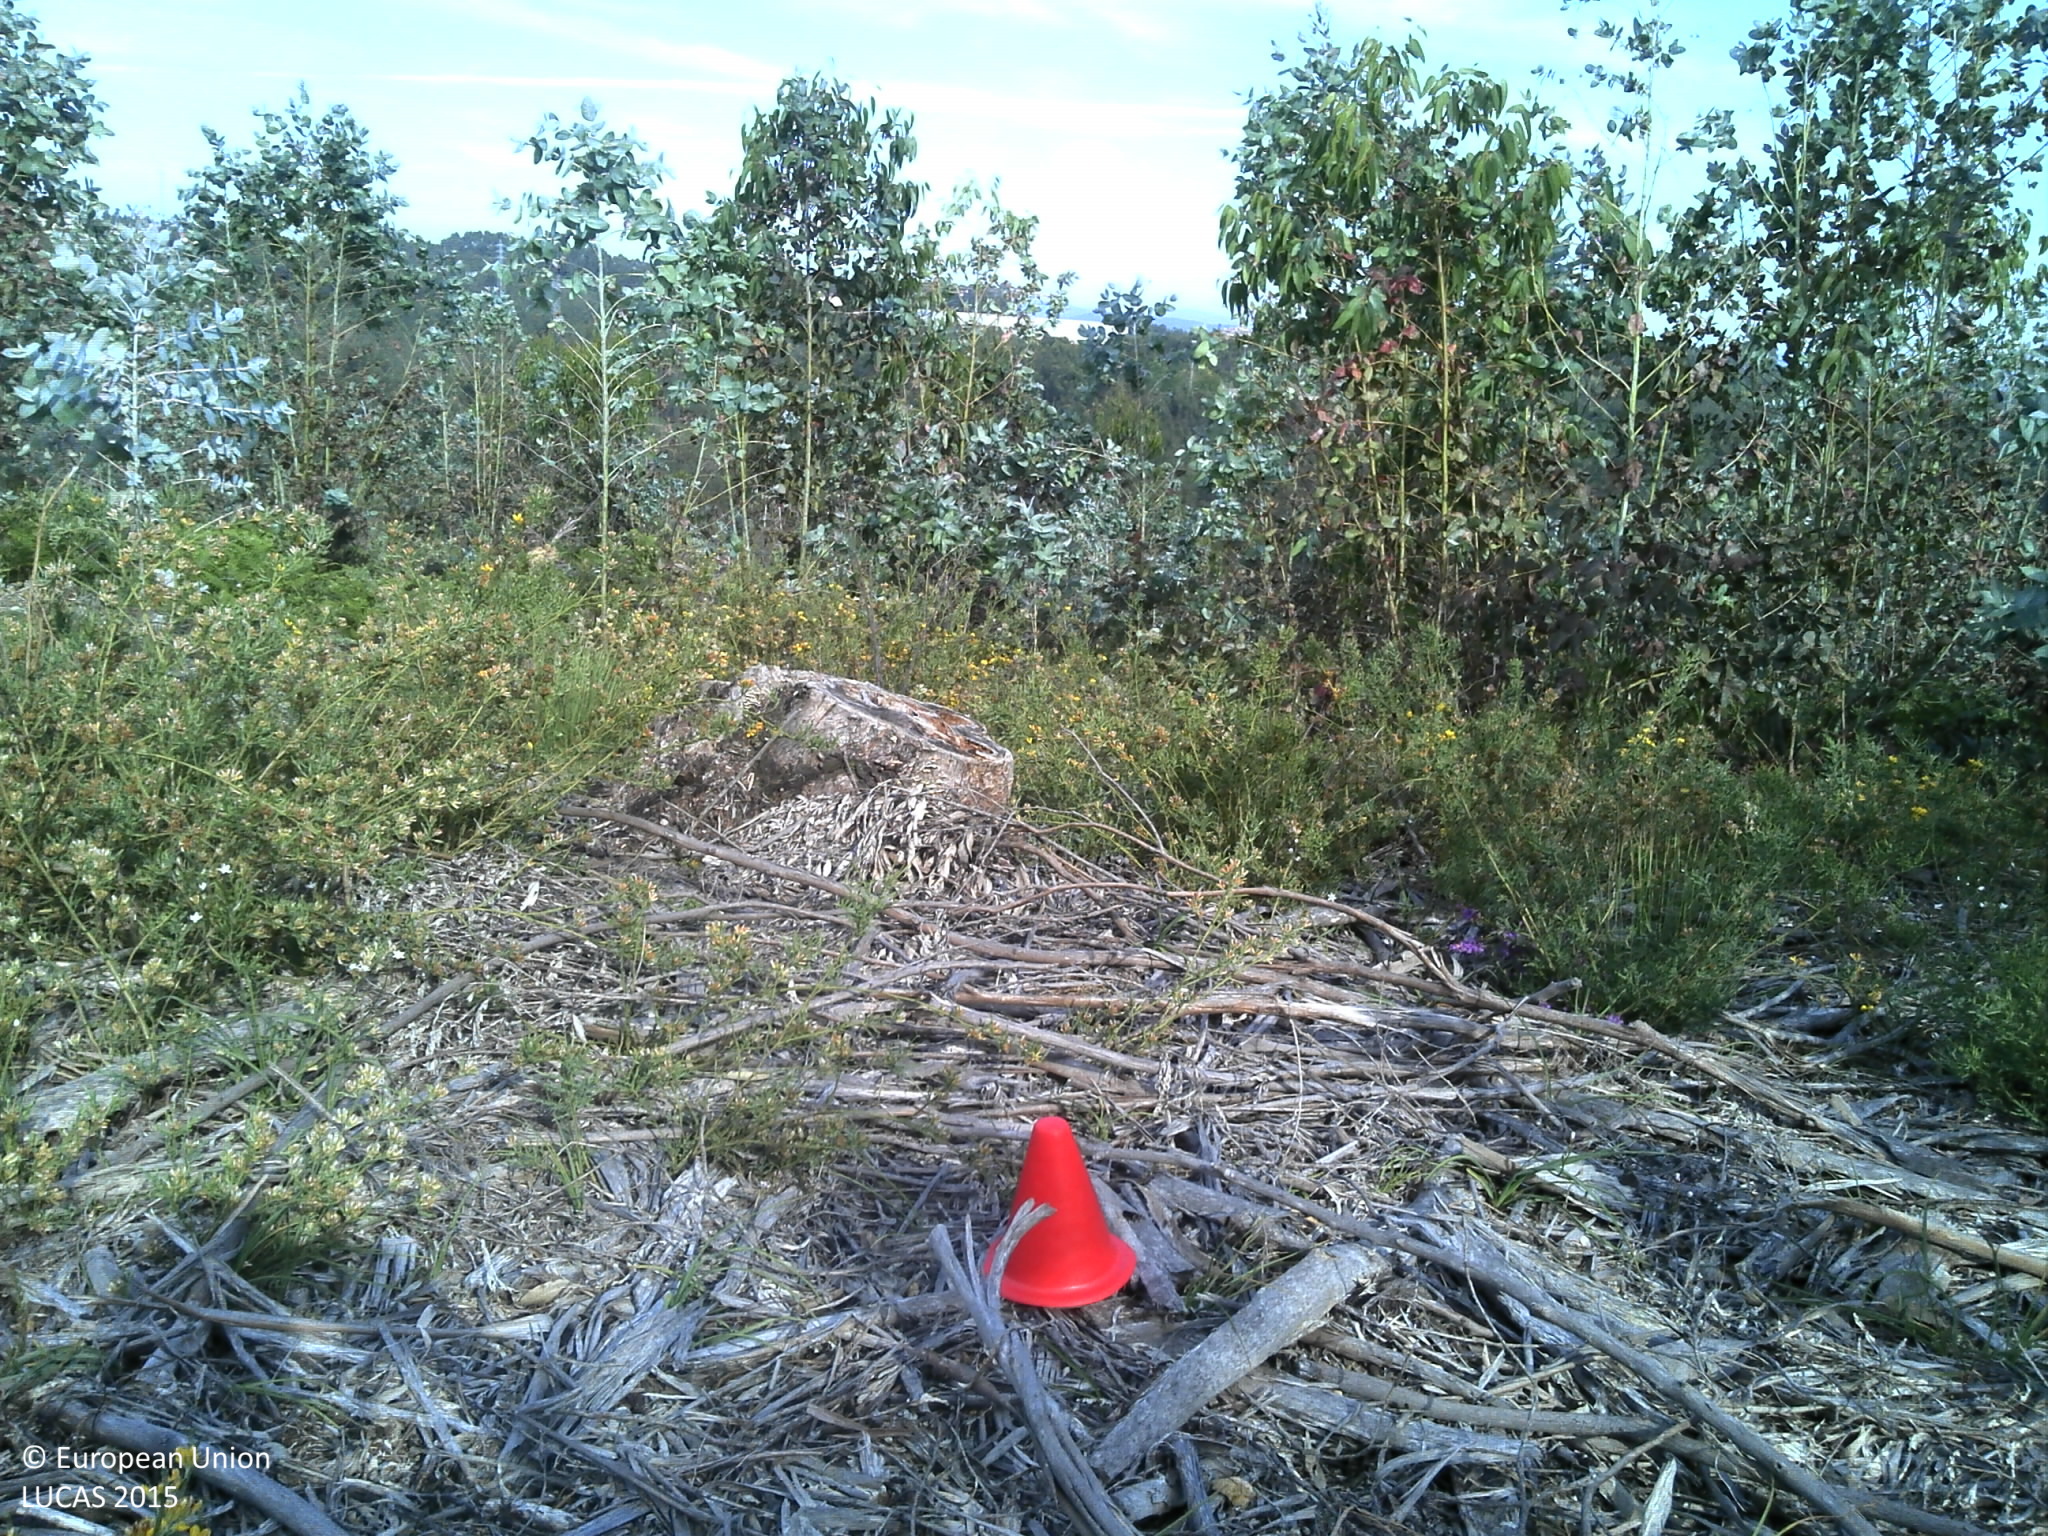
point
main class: Woodland
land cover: Broadleaved woodland
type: exotic forest
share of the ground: 10 - 25 %
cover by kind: unconsolidated bare surface 80 %, broadleaved forest trees 15 %, shrubs 5 %
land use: Forestry
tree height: < 5 m
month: May
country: PT
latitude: 40.9462
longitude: -8.5230
